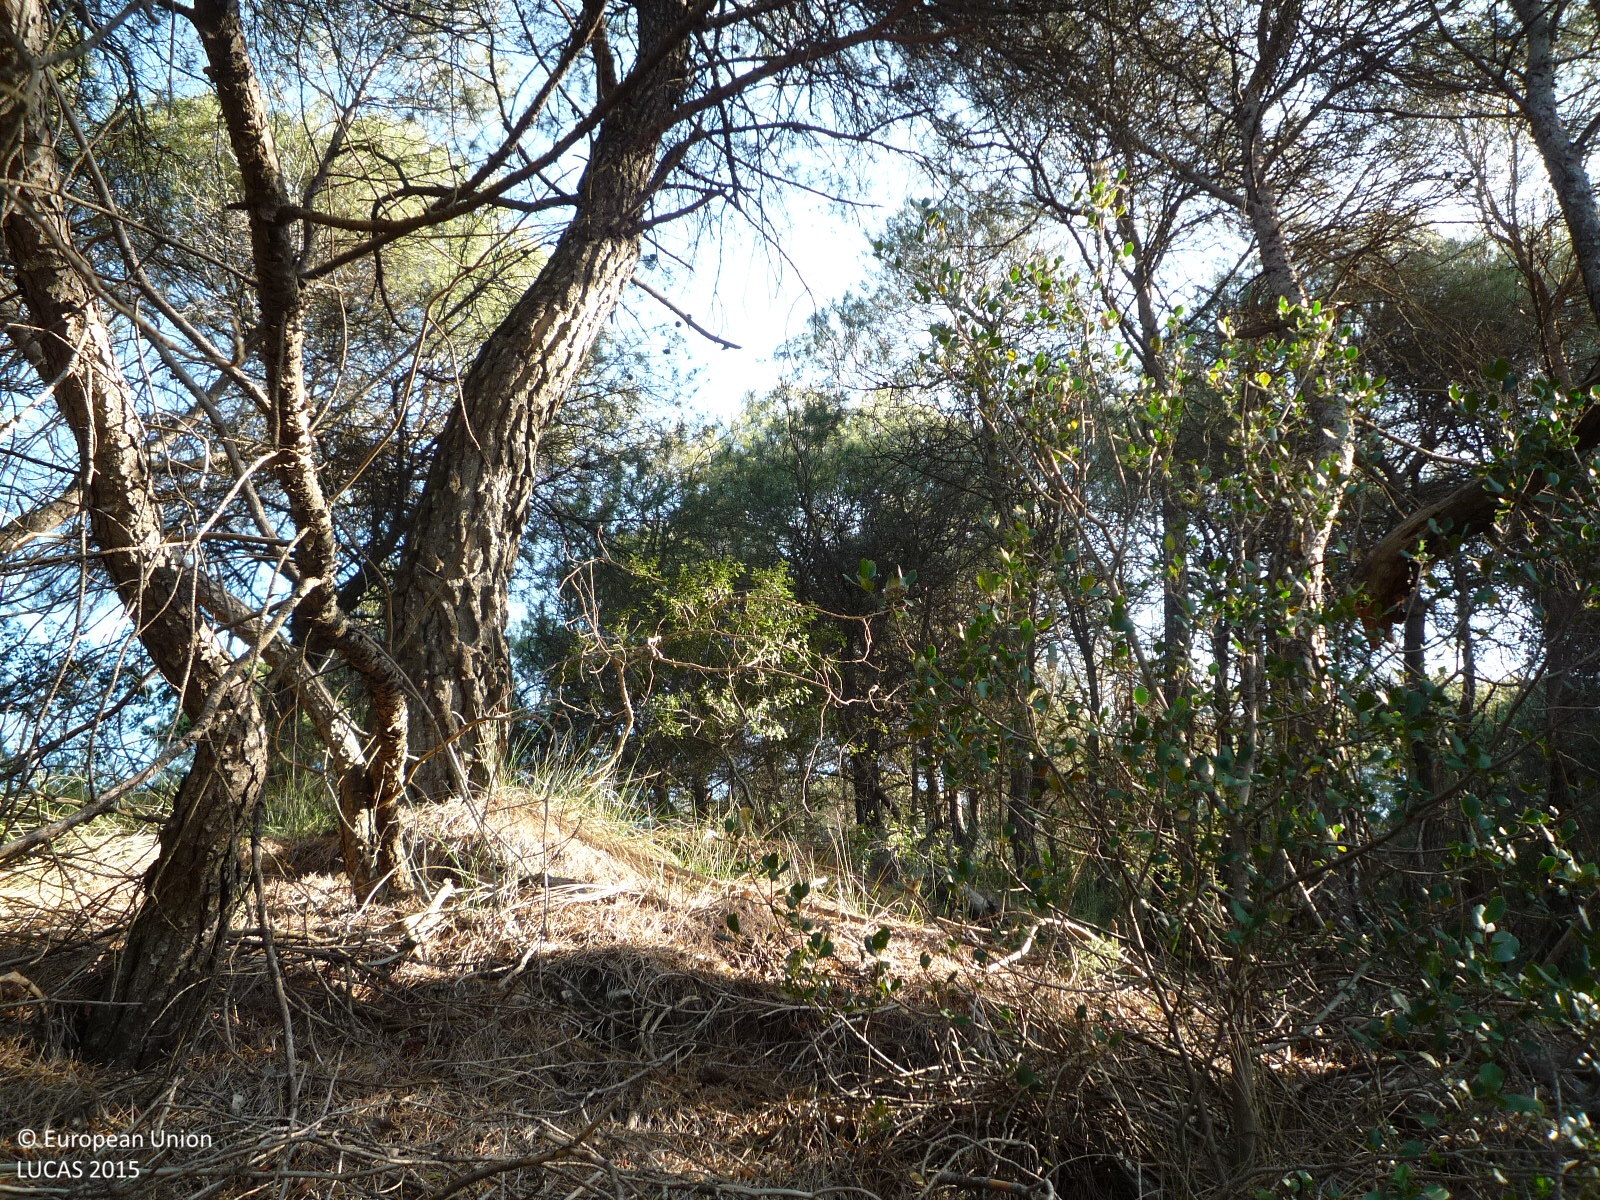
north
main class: Woodland
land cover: Pine dominated coniferous woodland
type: coniferous forest of the mediterranean region
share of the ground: > 75 %
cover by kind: coniferous forest trees 95 %, herbaceous plants 5 %
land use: Semi-natural and natural areas not in use
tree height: > 5 m
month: May
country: ES
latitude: 41.6700
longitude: 2.0528
